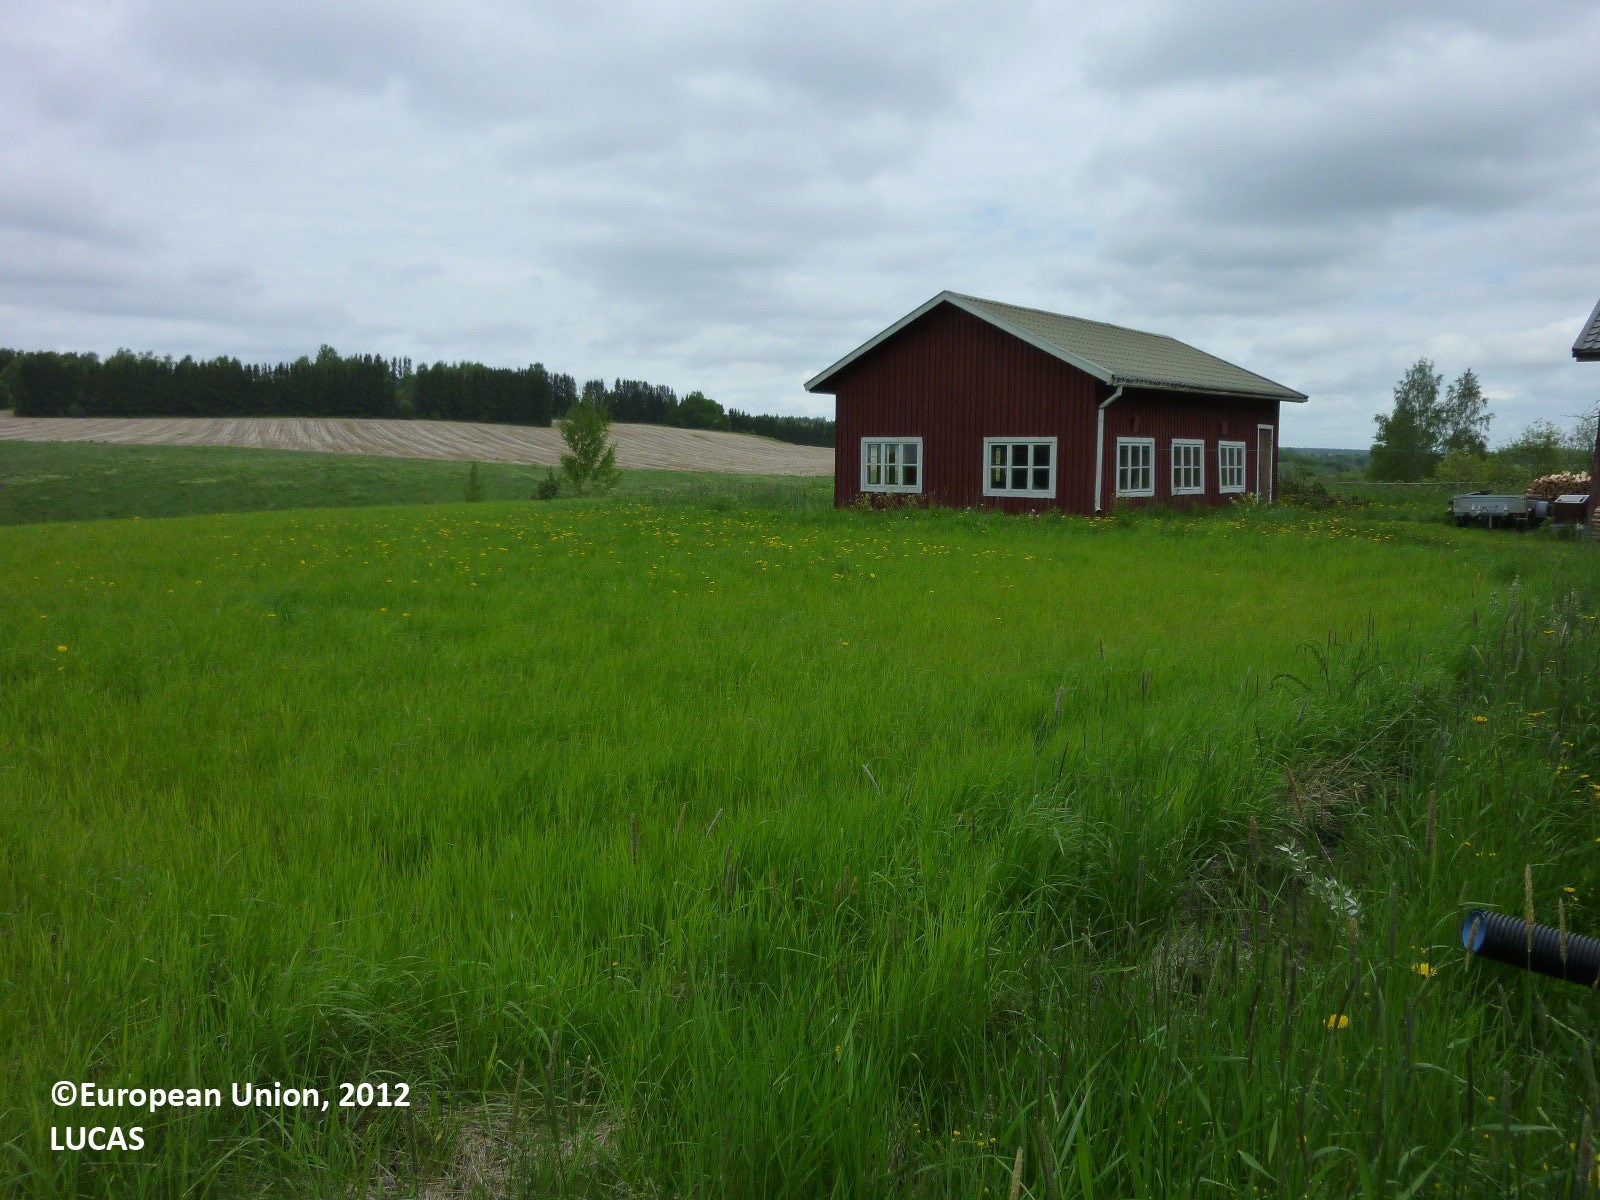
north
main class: Cropland
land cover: Temporary grasslands
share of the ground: > 75 %
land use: Agriculture (excluding fallow land and kitchen gardens)
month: June
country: FI
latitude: 60.4614
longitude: 22.7115
